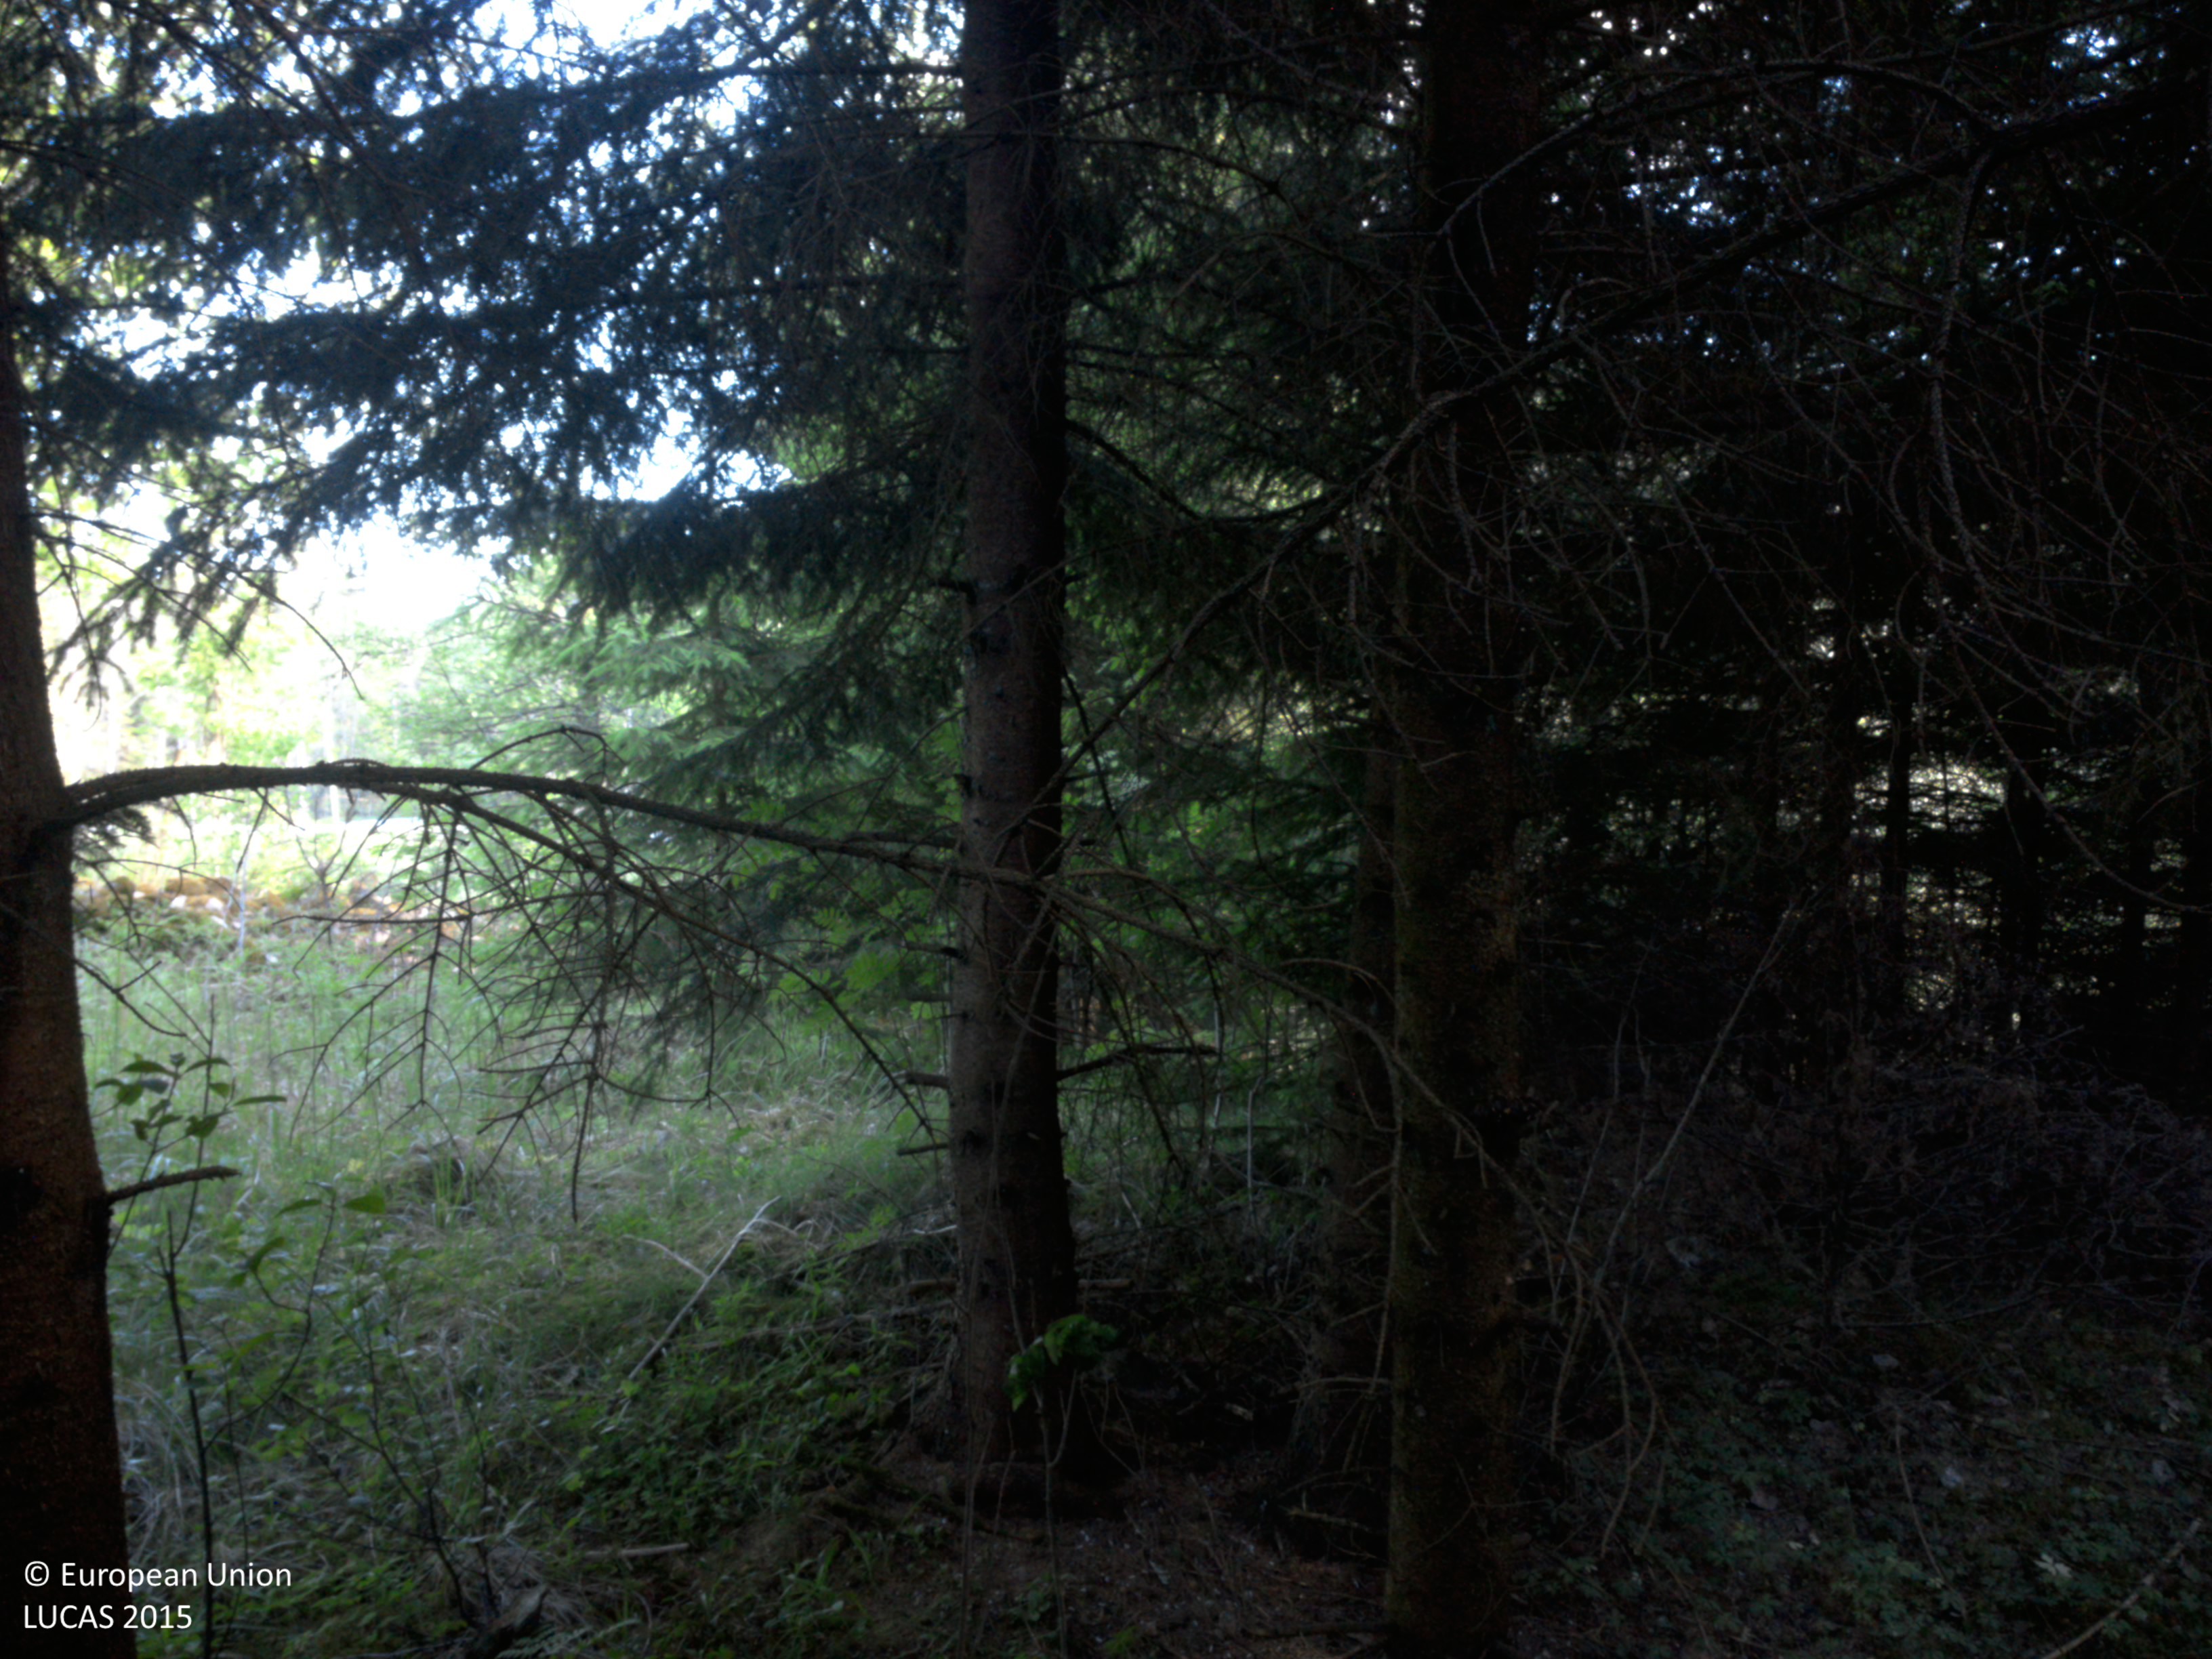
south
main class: Woodland
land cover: Spruce dominated coniferous woodland
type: boreal forest
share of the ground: > 75 %
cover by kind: coniferous forest trees 90 %, herbaceous plants 5 %, lichens and mosses 5 %
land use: Forestry
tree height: > 5 m
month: June
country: SE
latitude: 59.1027
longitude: 12.1076
